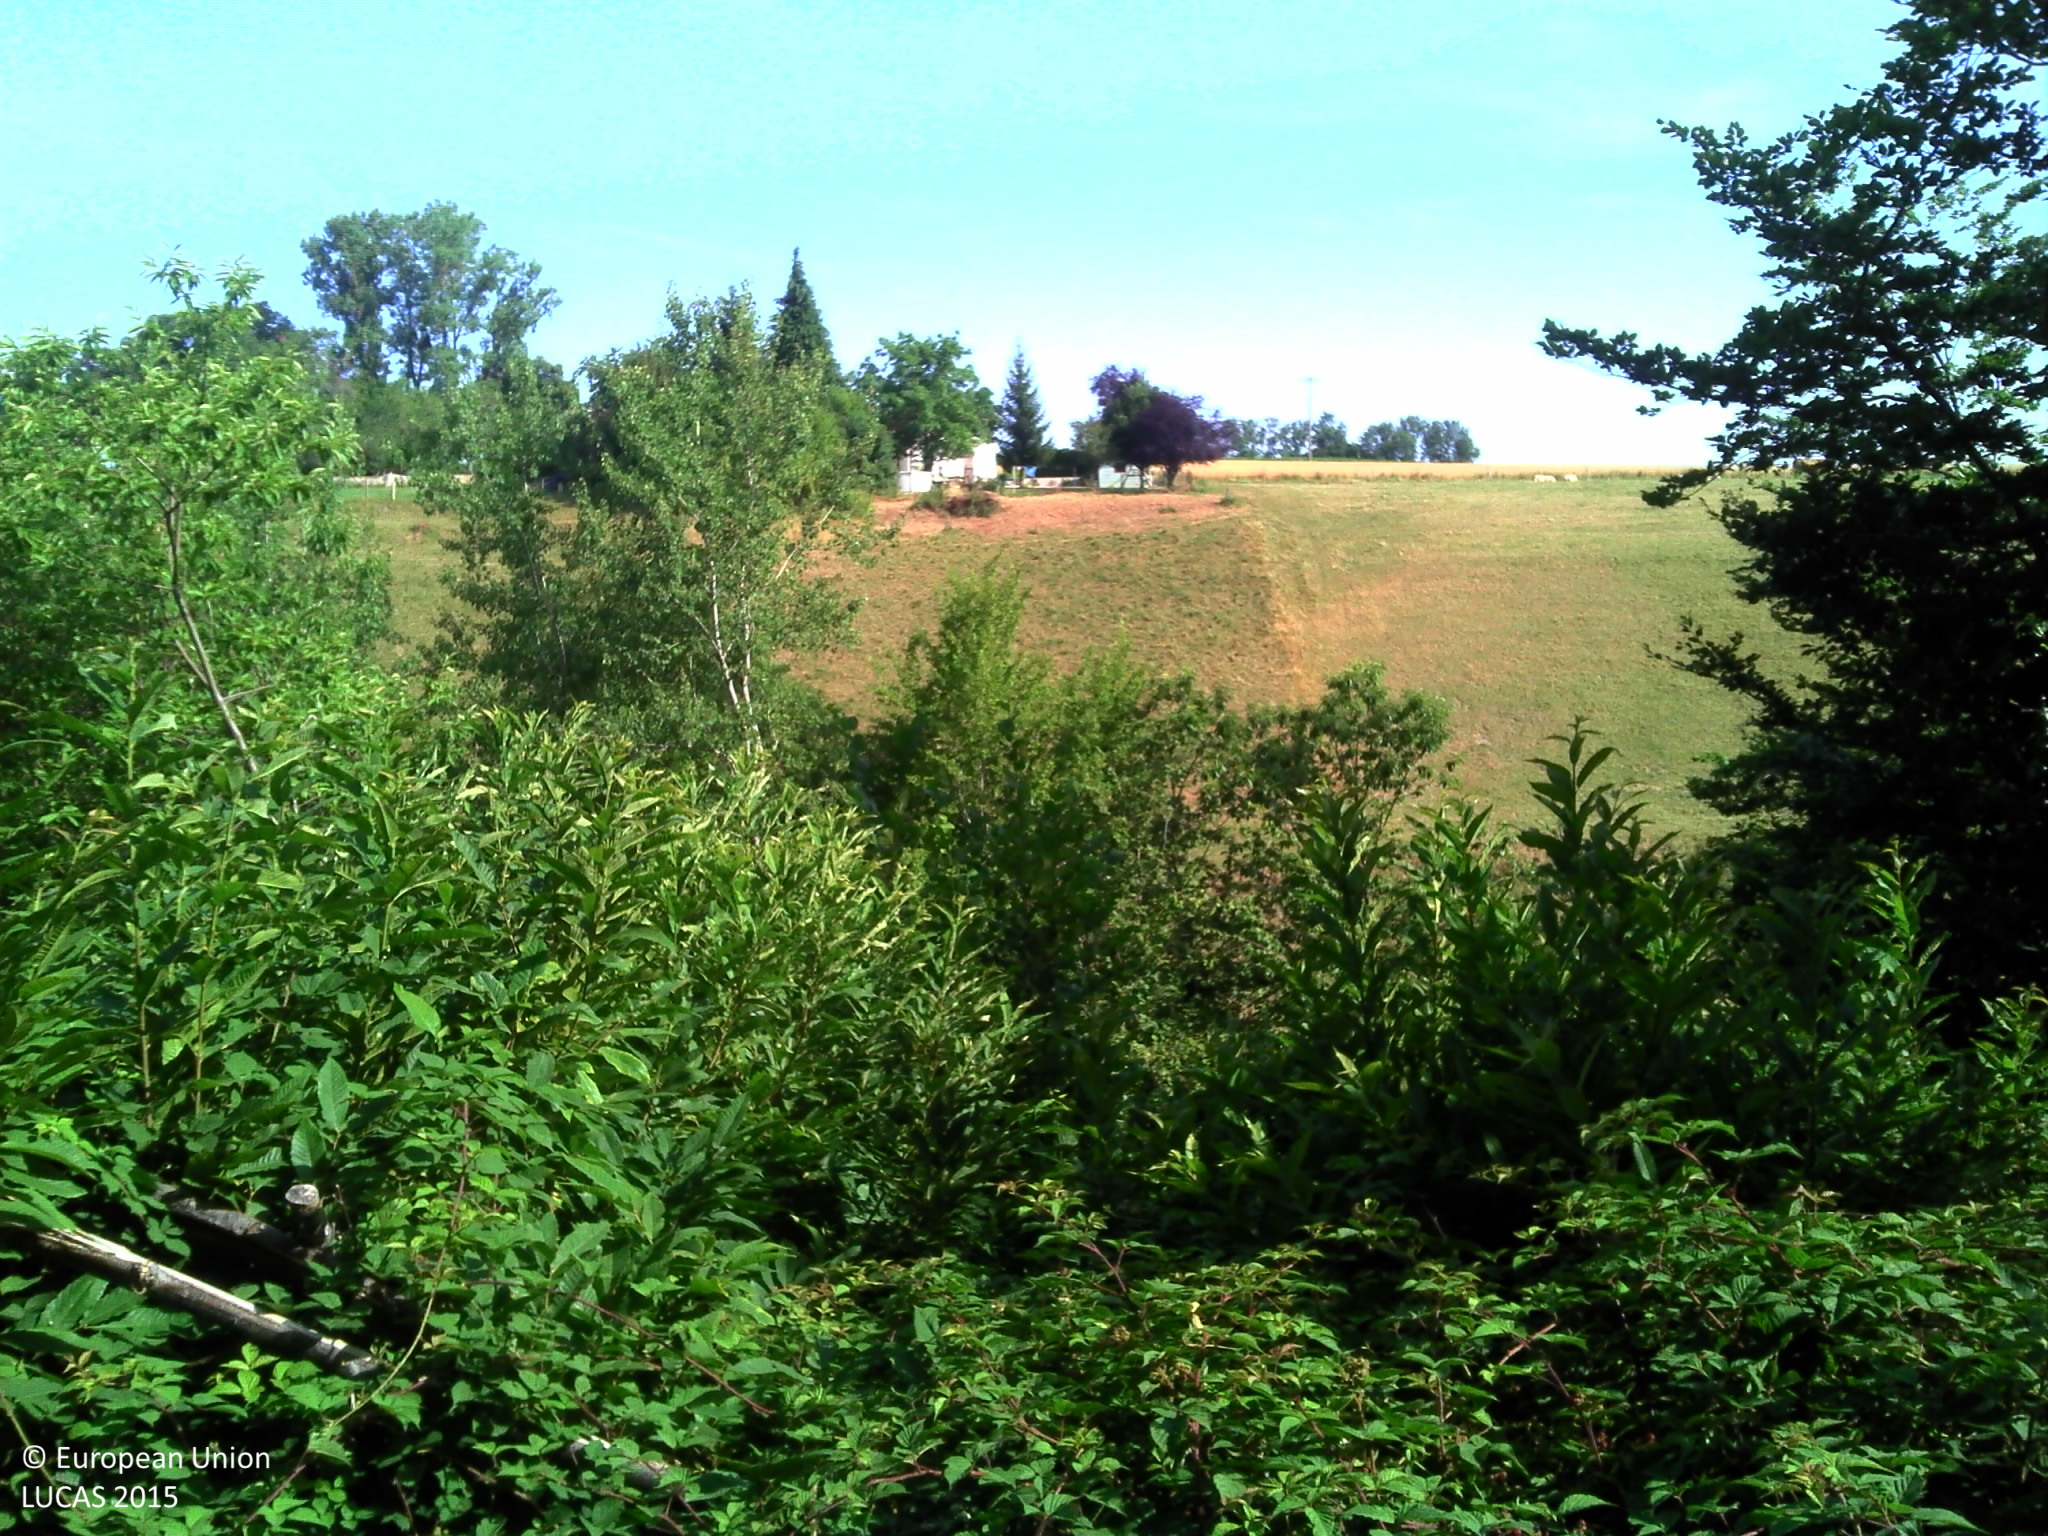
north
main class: Woodland
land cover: Broadleaved woodland
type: floodplain forest
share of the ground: > 75 %
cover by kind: broadleaved forest trees 50 %, herbaceous plants 50 %
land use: Forestry
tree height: > 5 m
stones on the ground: 10 - 25 %
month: July
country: FR
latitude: 45.4960
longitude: 5.4362
